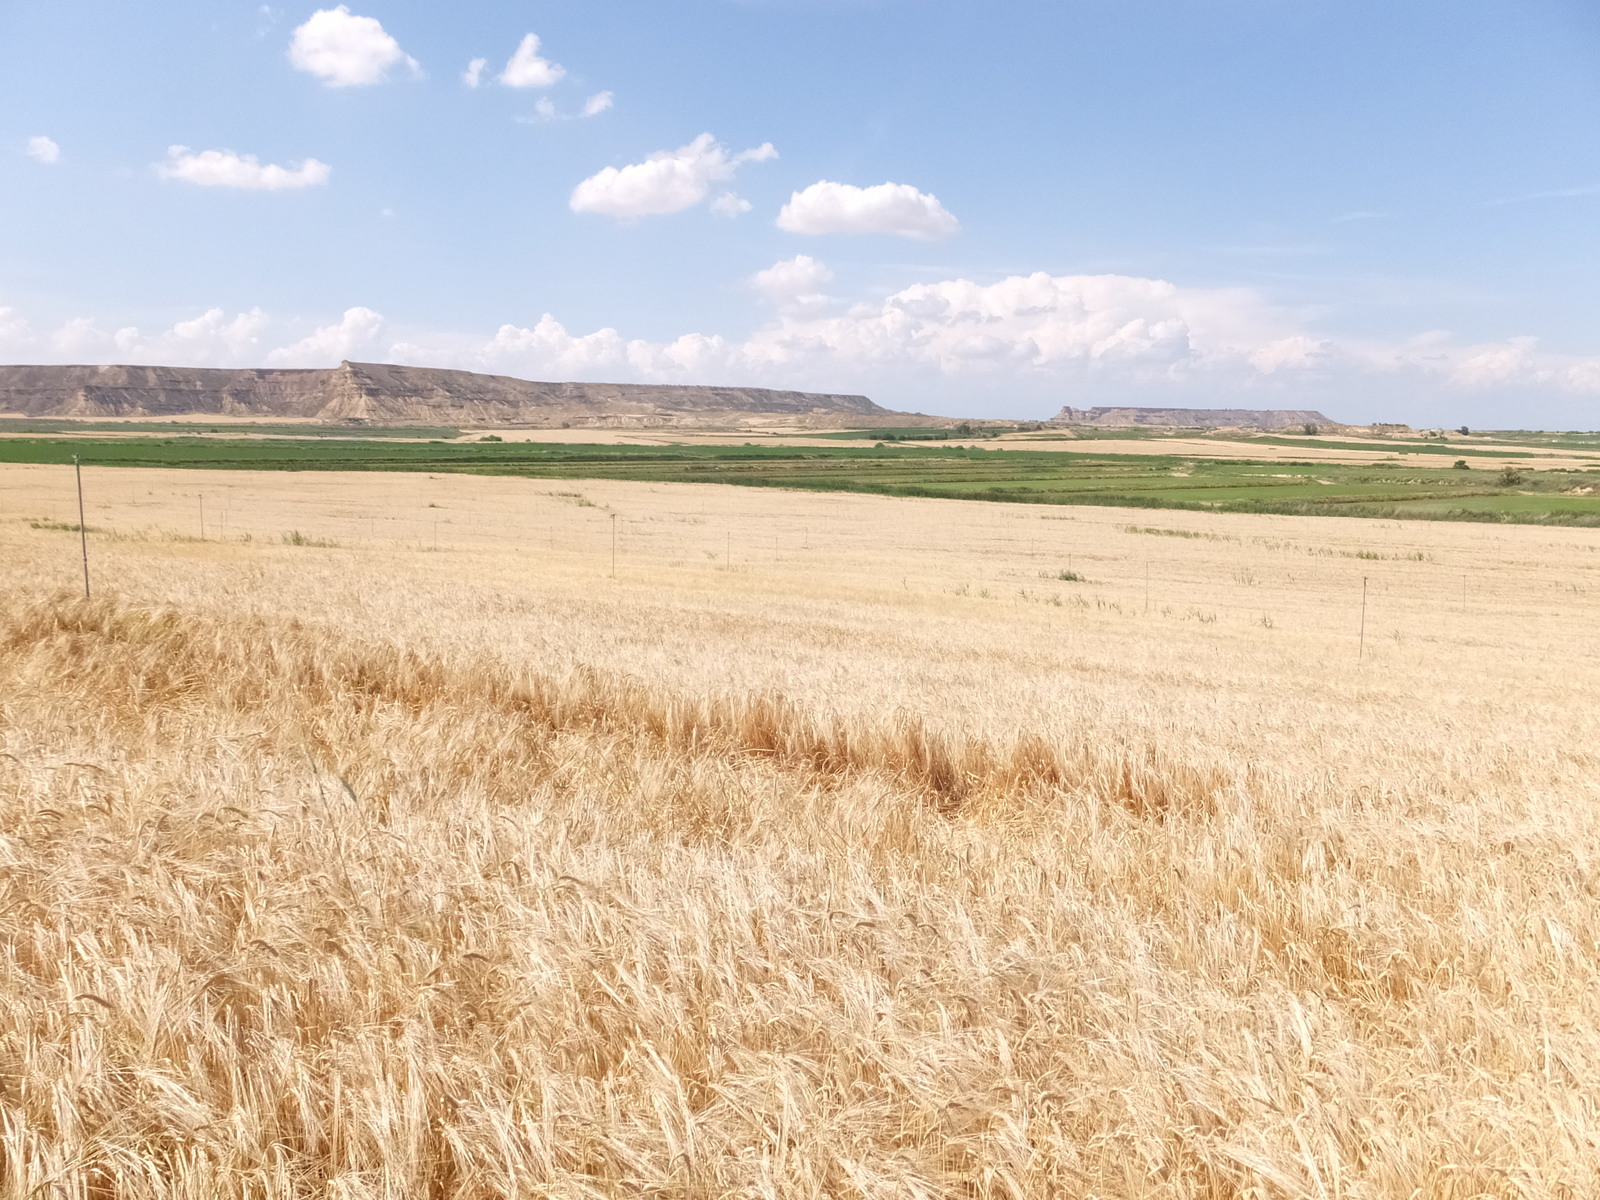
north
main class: Cropland
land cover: Barley
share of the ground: > 75 %
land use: Agriculture (excluding fallow land and kitchen gardens)
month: June
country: ES
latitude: 41.7949
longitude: 0.0066
